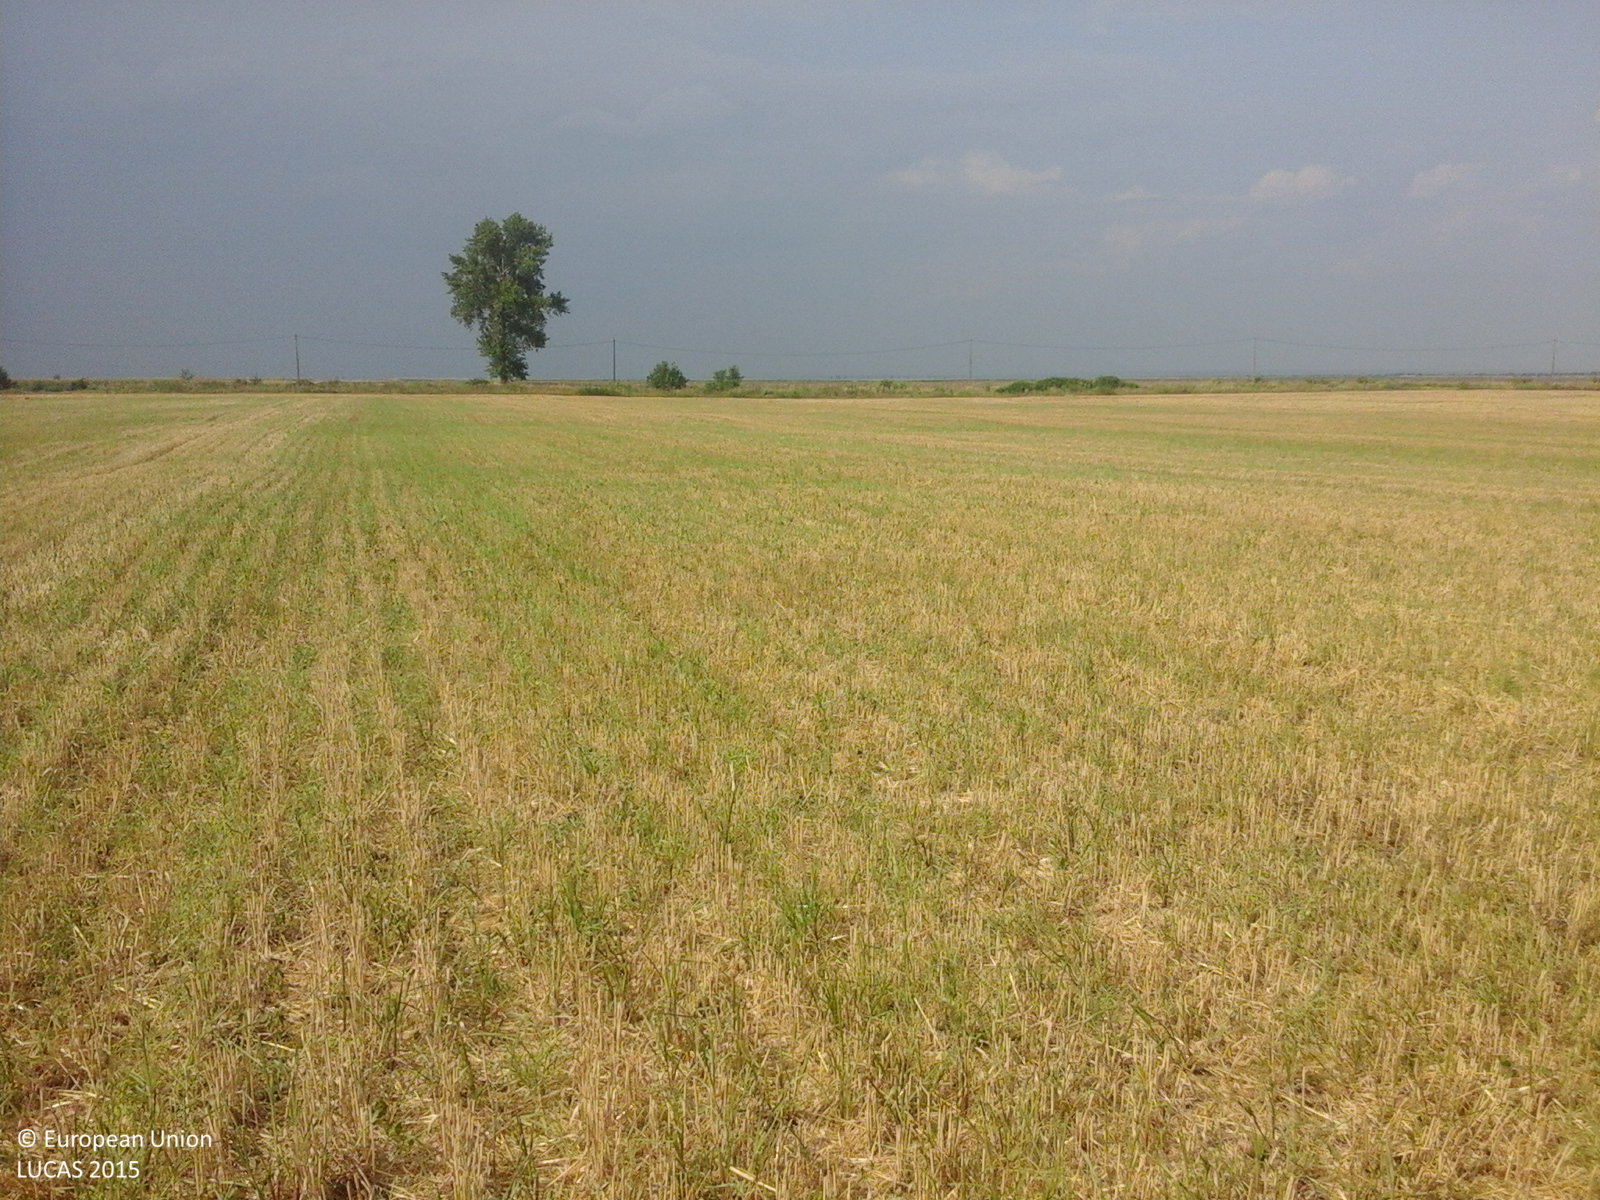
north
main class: Cropland
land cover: Common wheat
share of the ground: > 75 %
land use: Agriculture (excluding fallow land and kitchen gardens)
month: July
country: RO
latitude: 45.6860
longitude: 27.6081
